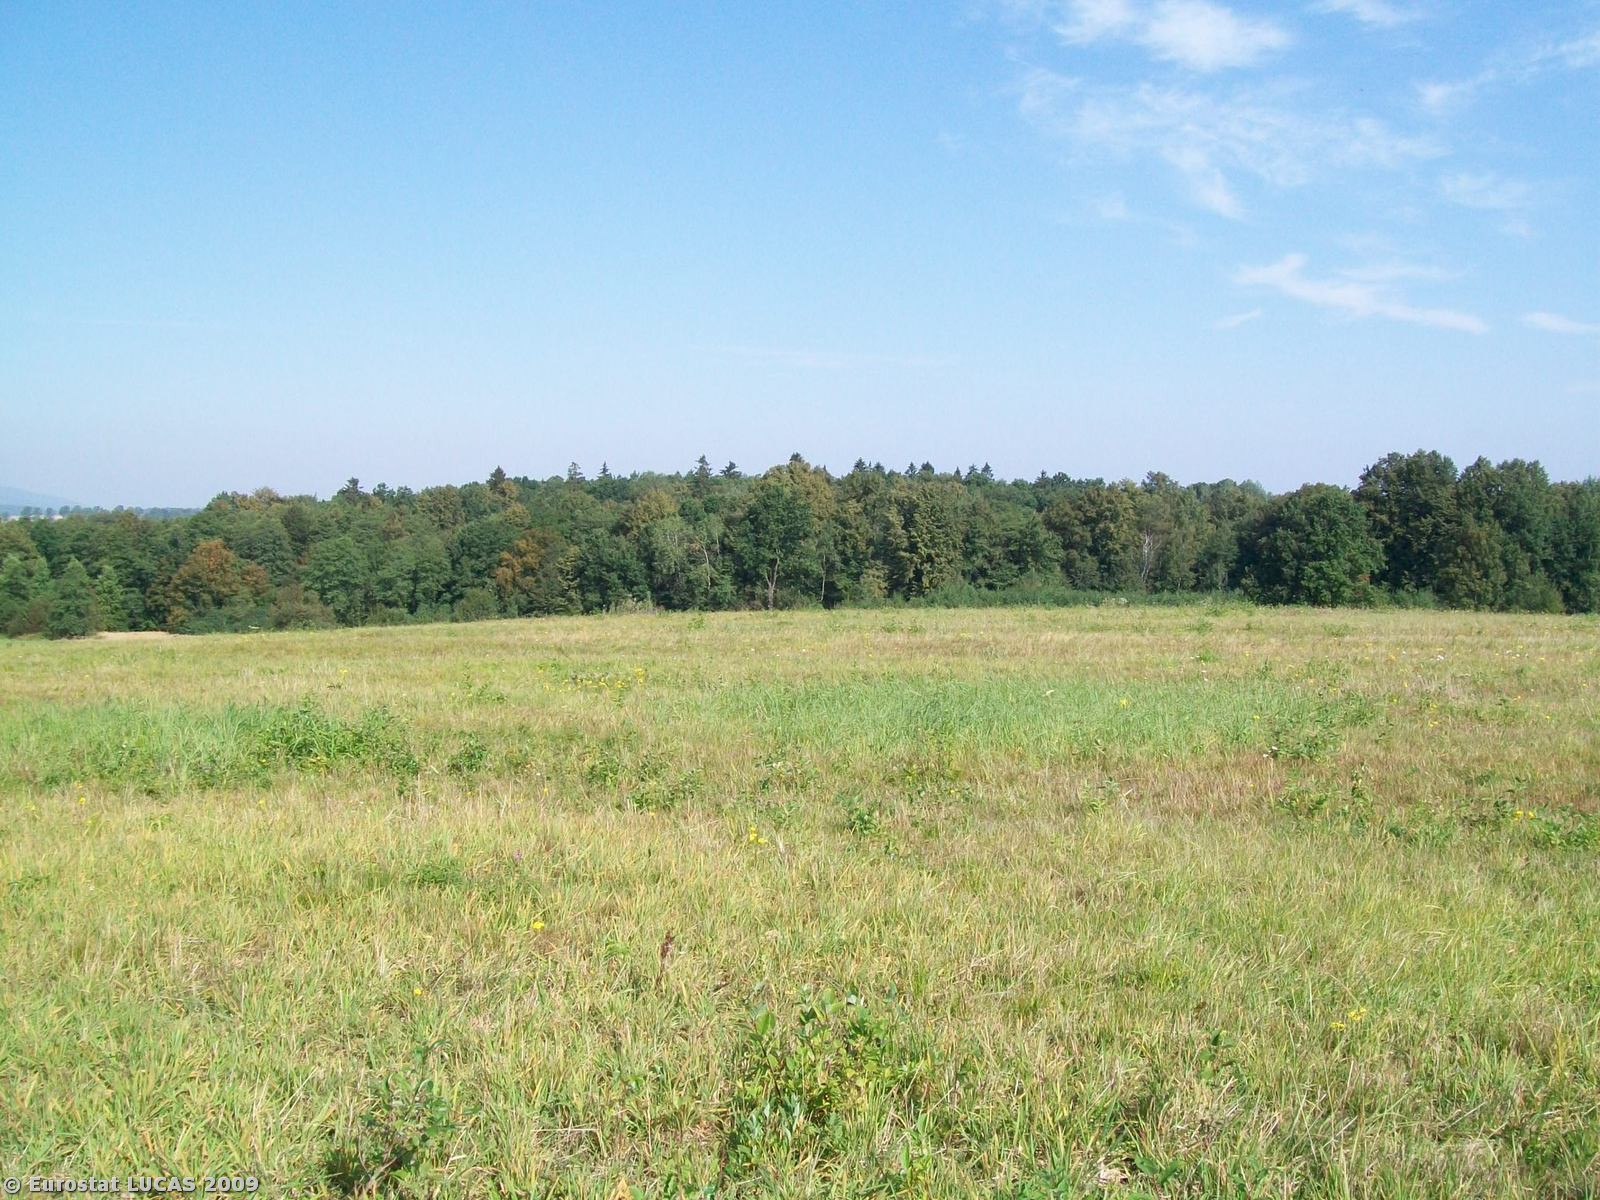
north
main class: Grassland
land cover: Grassland without tree/shrub cover
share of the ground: > 75 %
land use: Agriculture (excluding fallow land and kitchen gardens)
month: September
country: PL
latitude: 50.1863
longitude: 16.6890
